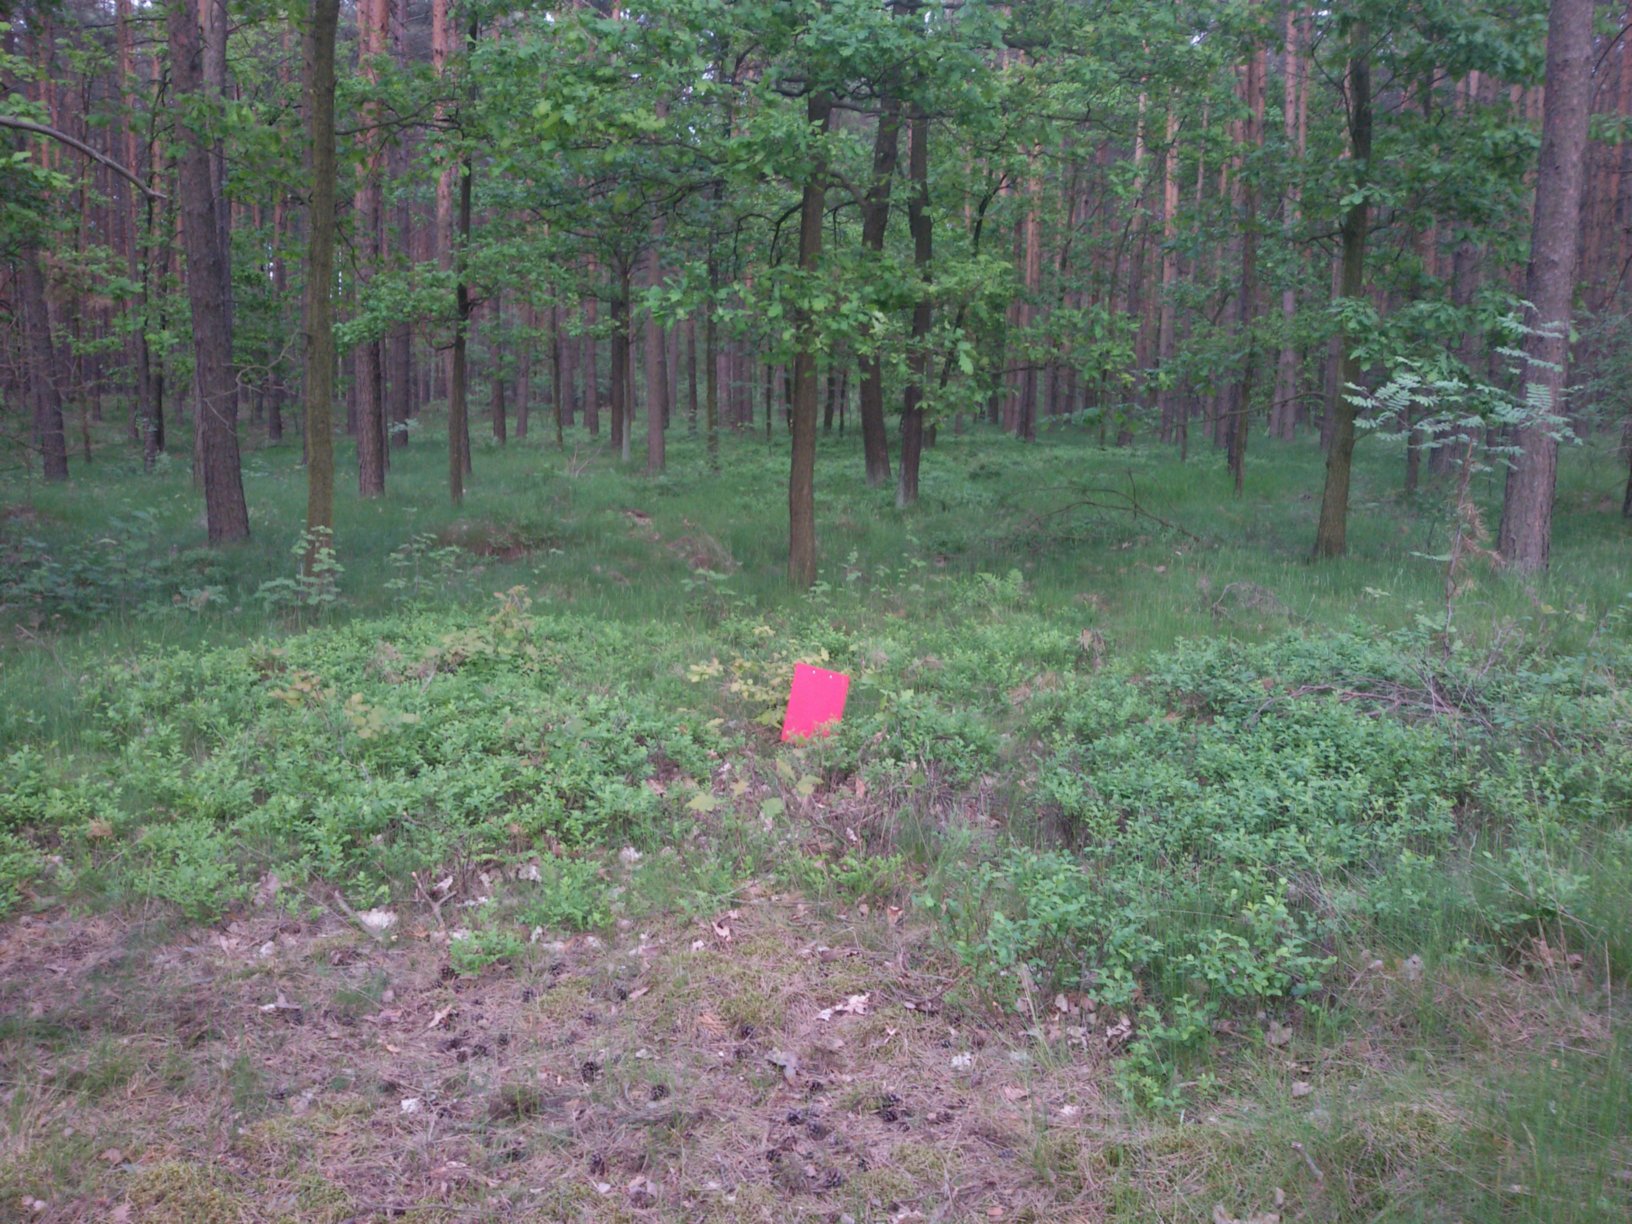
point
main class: Woodland
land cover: Pine dominated mixed woodland
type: hemiboreal forest and nemoral coniferous forest and mixed broadleaved-coniferous forest
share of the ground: > 75 %
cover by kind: coniferous forest trees 60 %, broadleaved forest trees 25 %, herbaceous plants 15 %
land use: Forestry
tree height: > 5 m
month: May
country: PL
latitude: 51.2414
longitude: 15.4904
